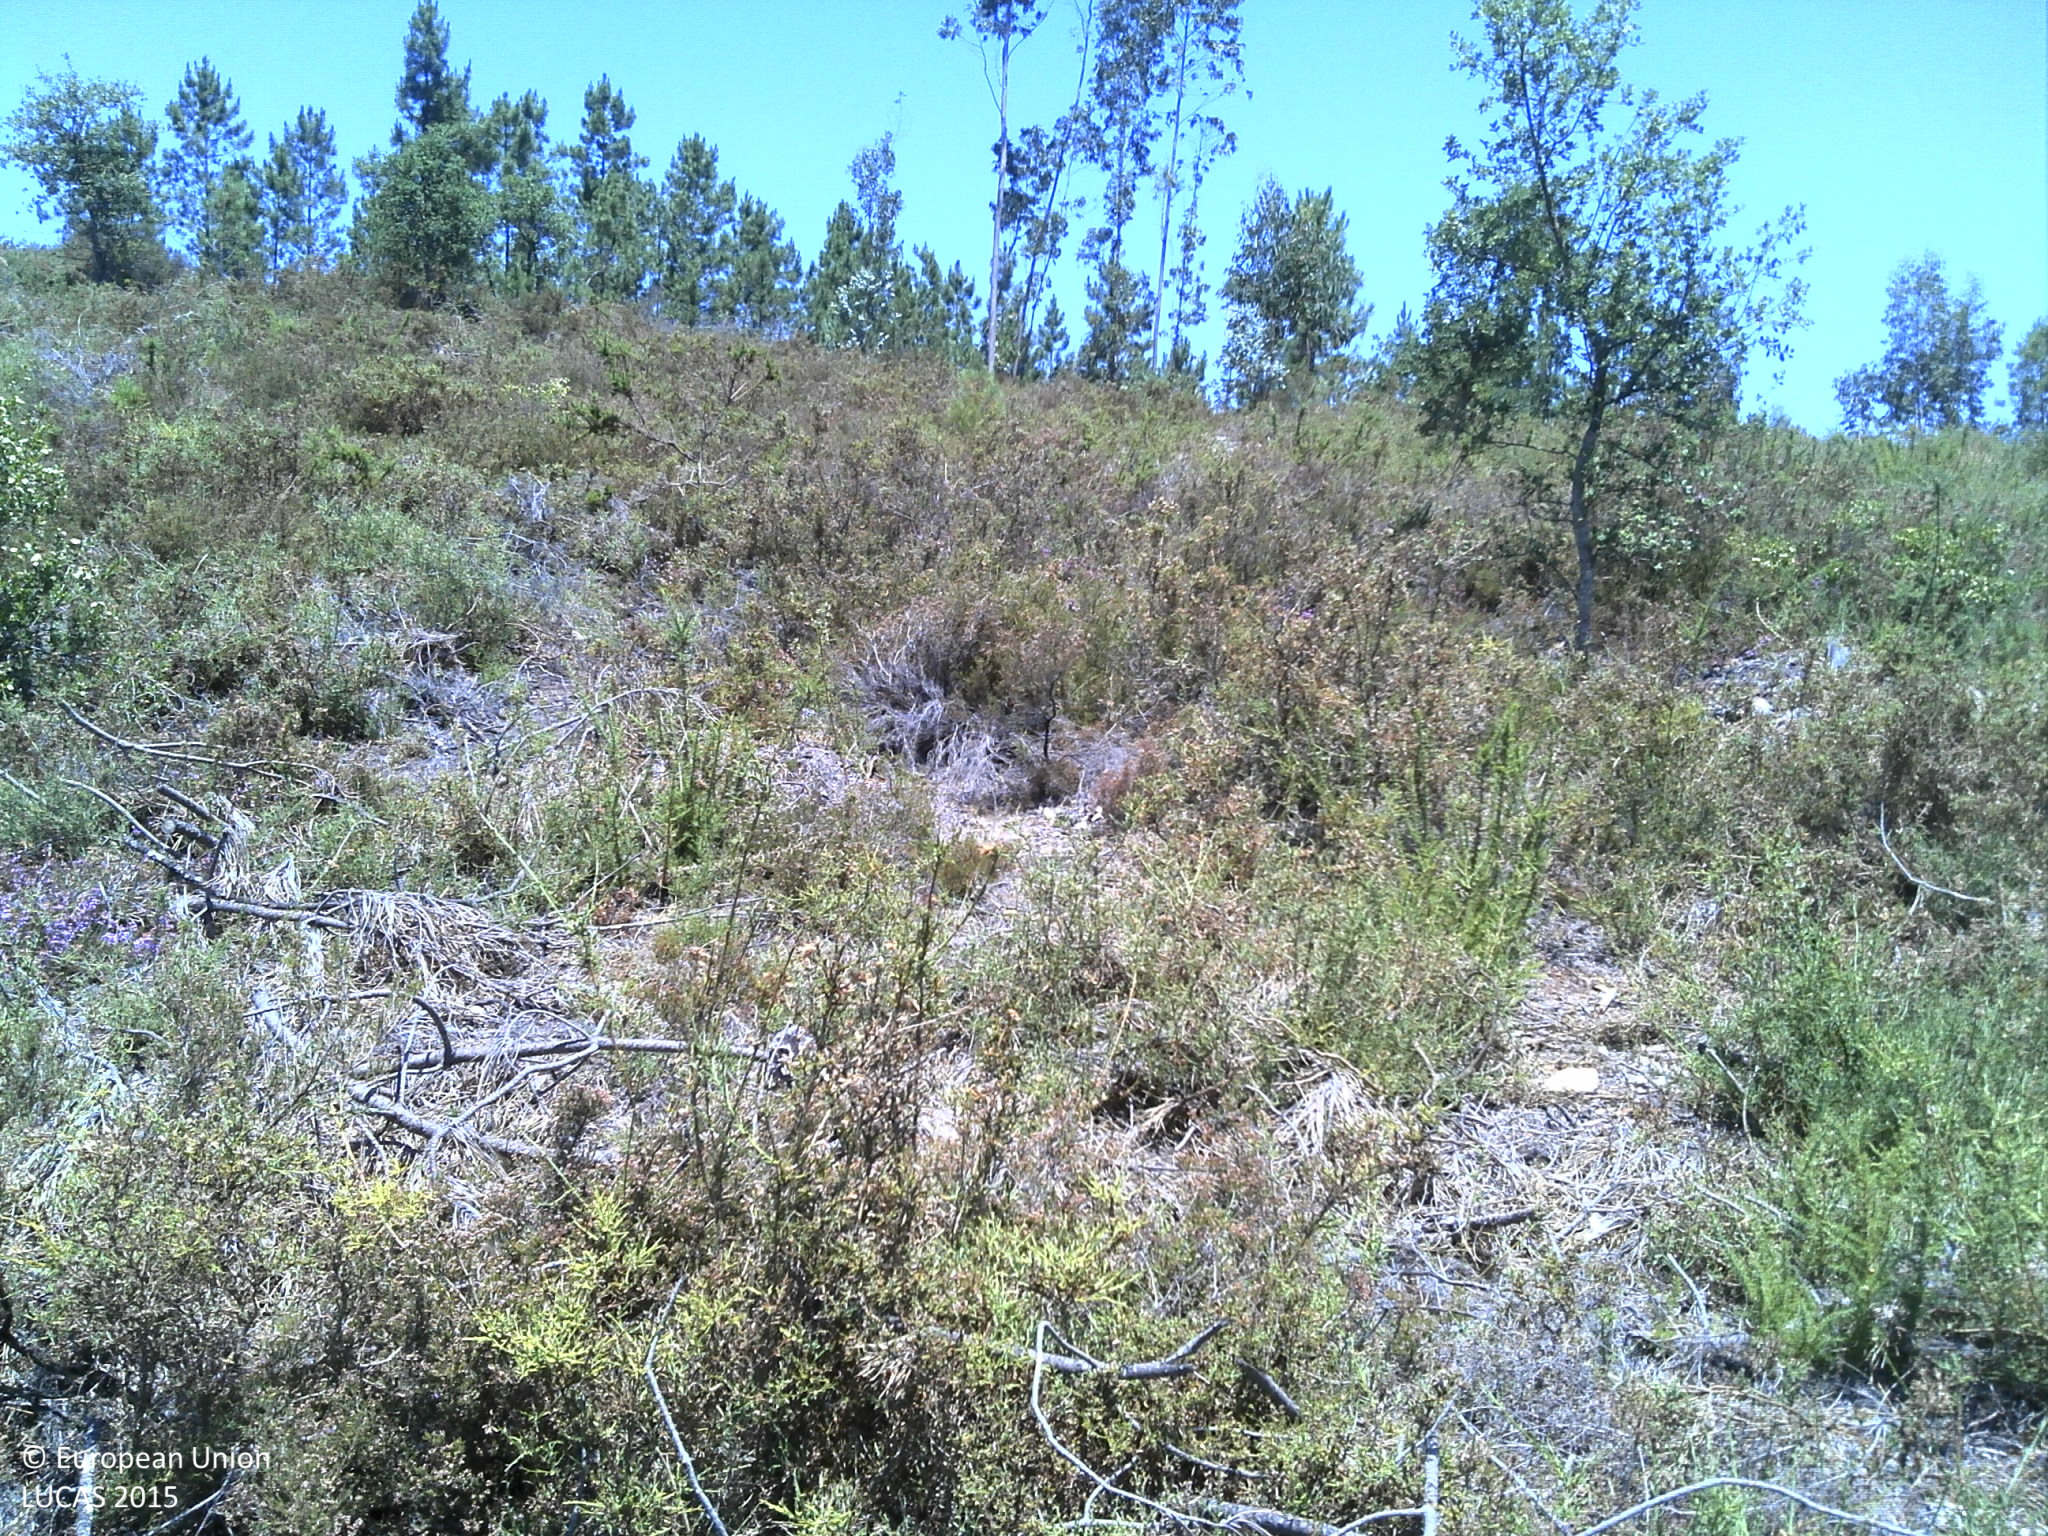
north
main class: Shrubland
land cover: Shrubland without tree cover
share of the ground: > 75 %
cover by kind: shrubs 90 %, unconsolidated bare surface 10 %
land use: Abandoned areas
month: June
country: PT
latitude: 40.1457
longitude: -8.2603
